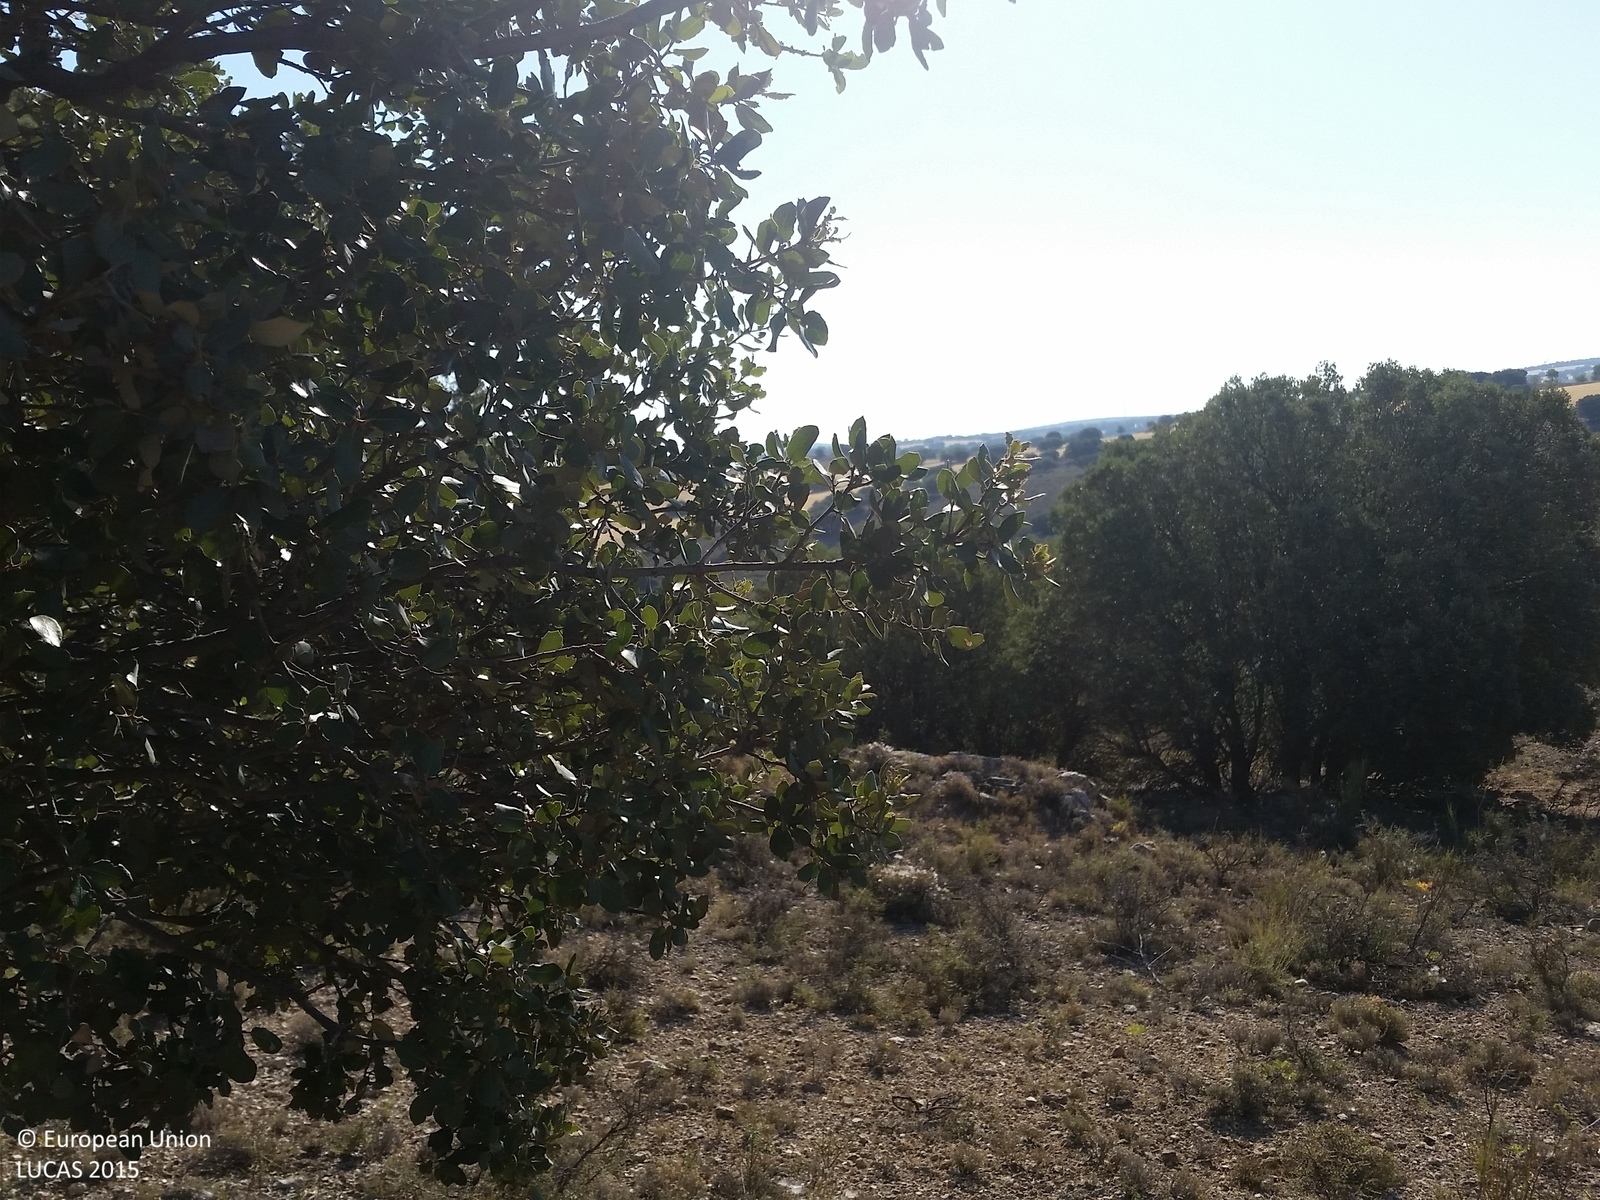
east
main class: Shrubland
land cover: Shrubland with sparse tree cover
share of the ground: > 75 %
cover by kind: shrubs 60 %, consolidated bare surface 25 %, herbaceous plants 10 %, broadleaved forest trees 5 %
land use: Semi-natural and natural areas not in use
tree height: < 5 m
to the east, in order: Shrubland with sparse tree cover; Tracks; Shrubland with sparse tree cover; Tracks; Shrubland with sparse tree cover; Tracks; Broadleaved woodland
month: July
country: ES
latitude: 38.9878
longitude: -2.5085
